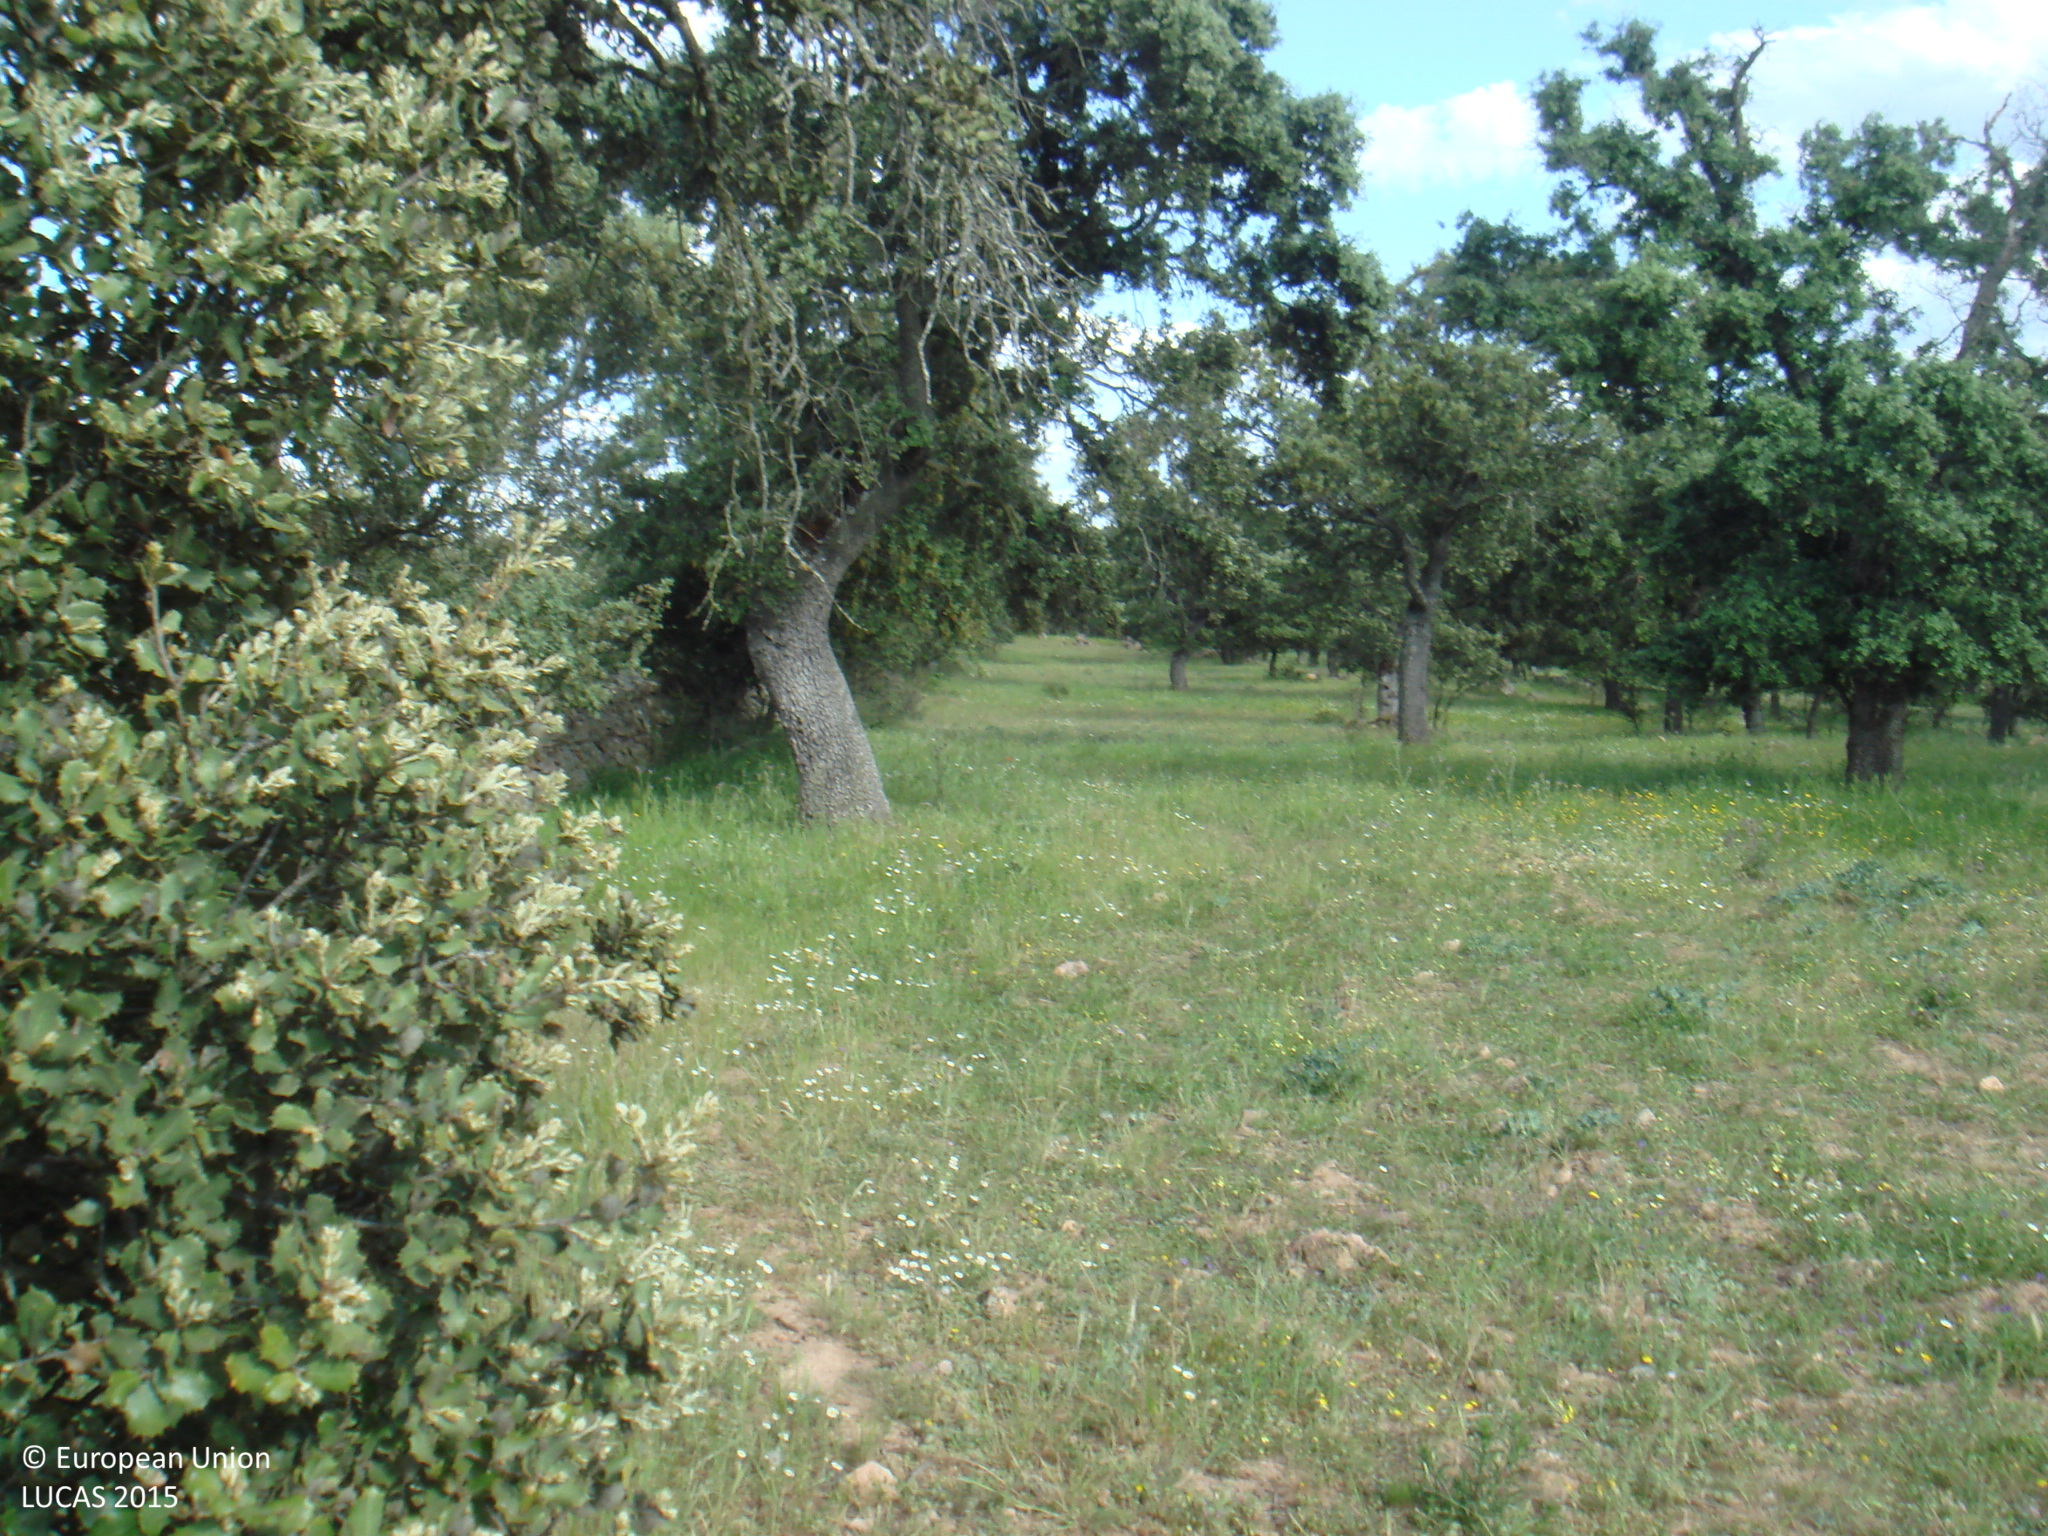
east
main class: Woodland
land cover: Broadleaved woodland
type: broadleaved evergreen forest
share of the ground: 10 - 25 %
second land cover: Shrubland without tree cover
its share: 10 - 25 %
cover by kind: herbaceous plants 70 %, broadleaved forest trees 20 %, shrubs 10 %
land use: Forestry
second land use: Fallow land
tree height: > 5 m
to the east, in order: Broadleaved woodland; Shrubland without tree cover; Dry stone walls; Fences; Broadleaved woodland; Dry stone walls; Fences; Broadleaved woodland; Grassland with sparse tree/shrub cover; Spontaneously vegetated surfaces; Broadleaved woodland
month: May
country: ES
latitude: 38.3771
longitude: -4.7311
